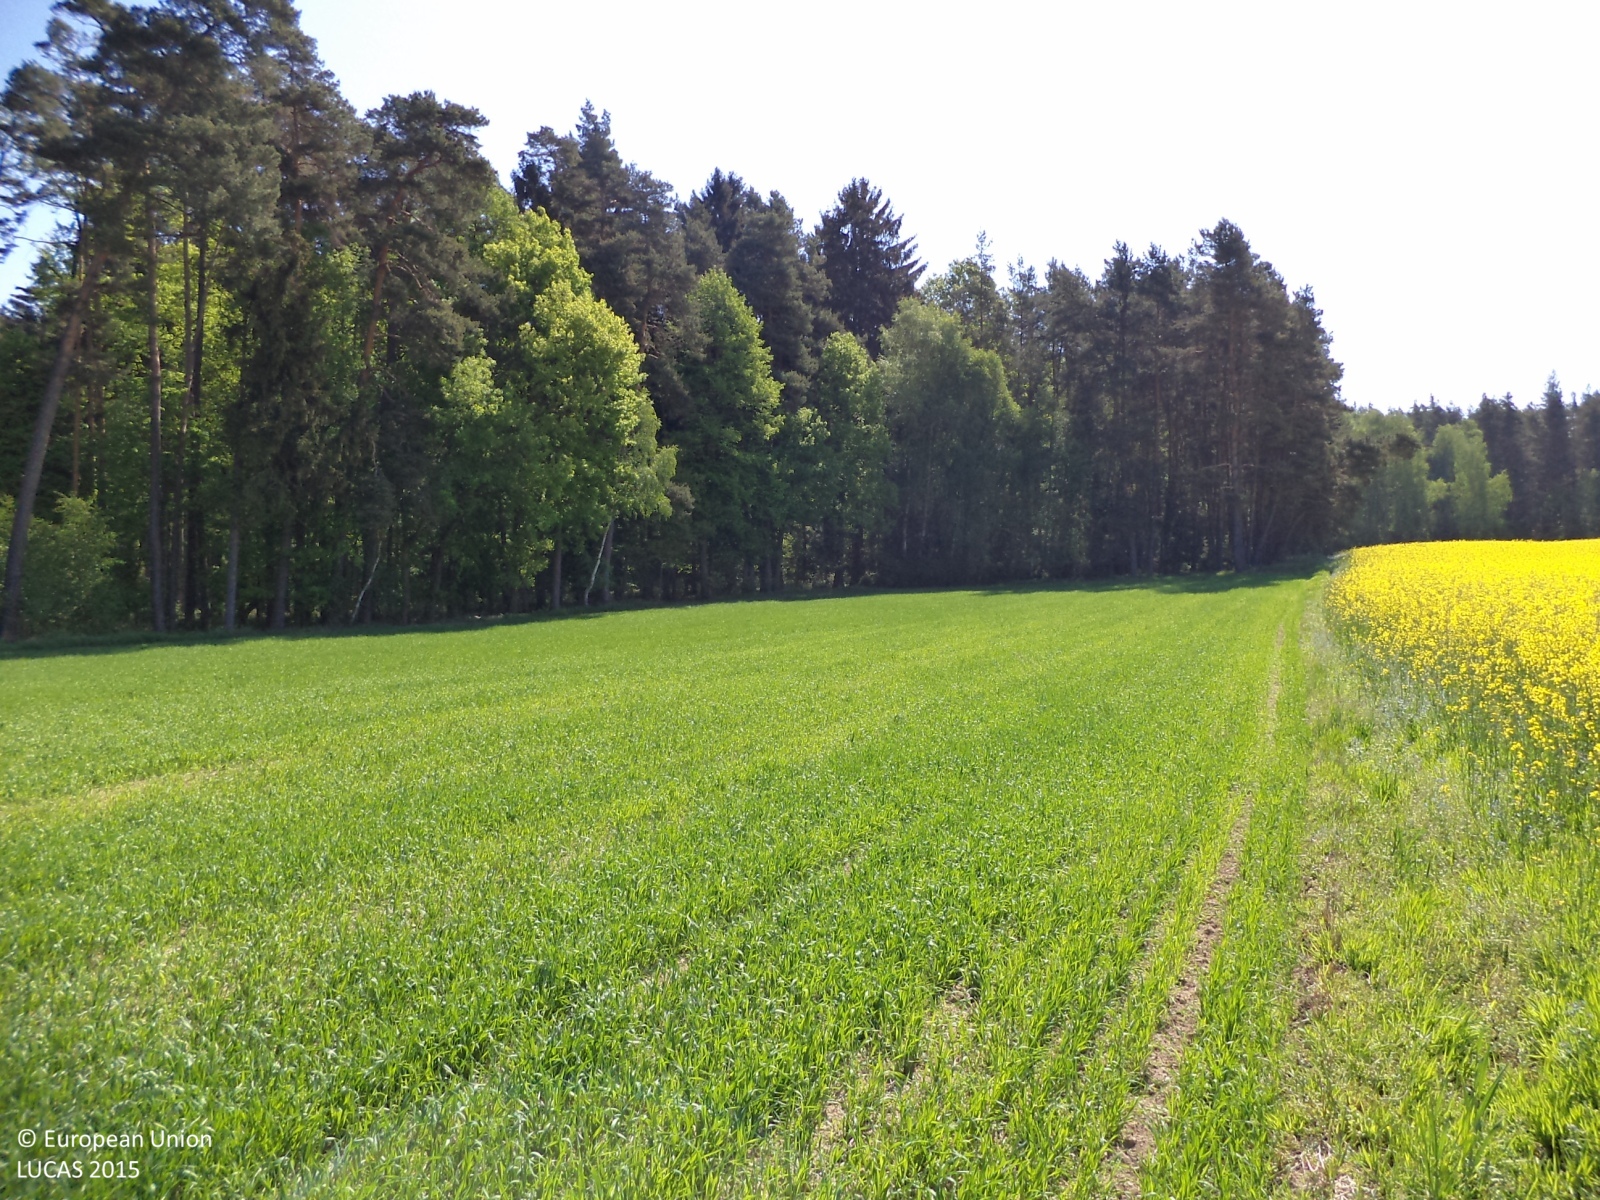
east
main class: Cropland
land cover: Rape and turnip rape
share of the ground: > 75 %
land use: Agriculture (excluding fallow land and kitchen gardens)
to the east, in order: Rape and turnip rape; Pine dominated coniferous woodland; Tracks; Pine dominated coniferous woodland
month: May
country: CZ
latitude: 49.2499
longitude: 14.9065
